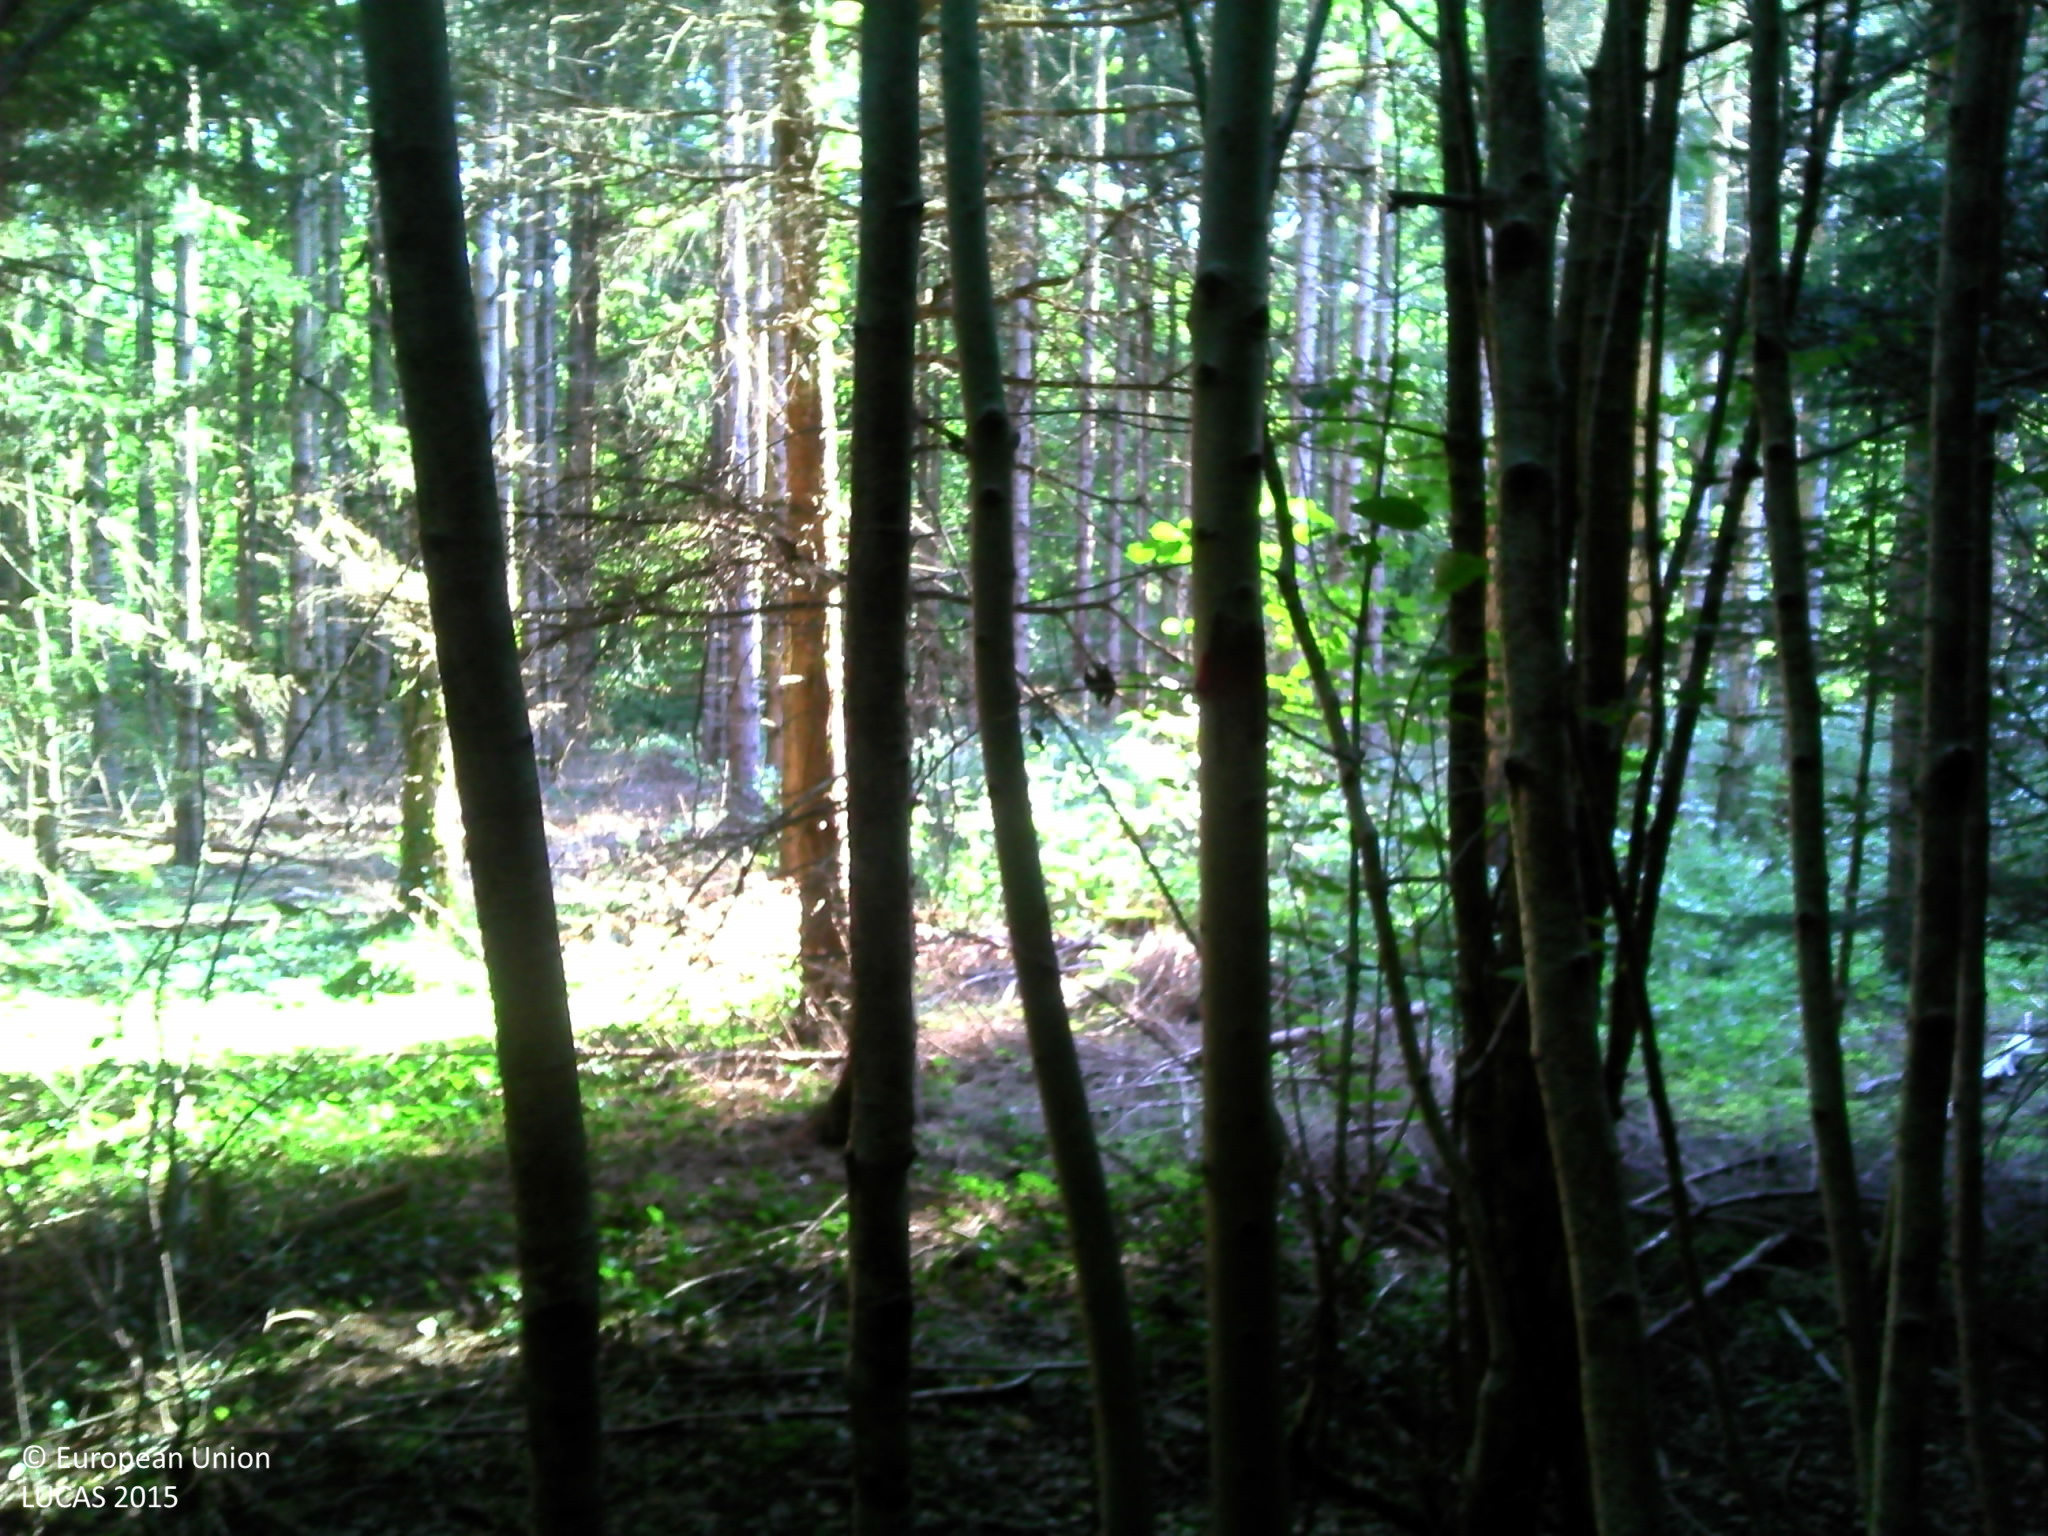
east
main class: Woodland
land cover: Spruce dominated coniferous woodland
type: alpine coniferous forest
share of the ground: > 75 %
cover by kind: coniferous forest trees 70 %, herbaceous plants 20 %, shrubs 10 %
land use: Forestry
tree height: > 5 m
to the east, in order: Spruce dominated coniferous woodland; Dry stone walls; Broadleaved woodland; Spruce dominated coniferous woodland; Fences; Grassland without tree/shrub cover
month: September
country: FR
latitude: 47.2243
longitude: 6.2909
